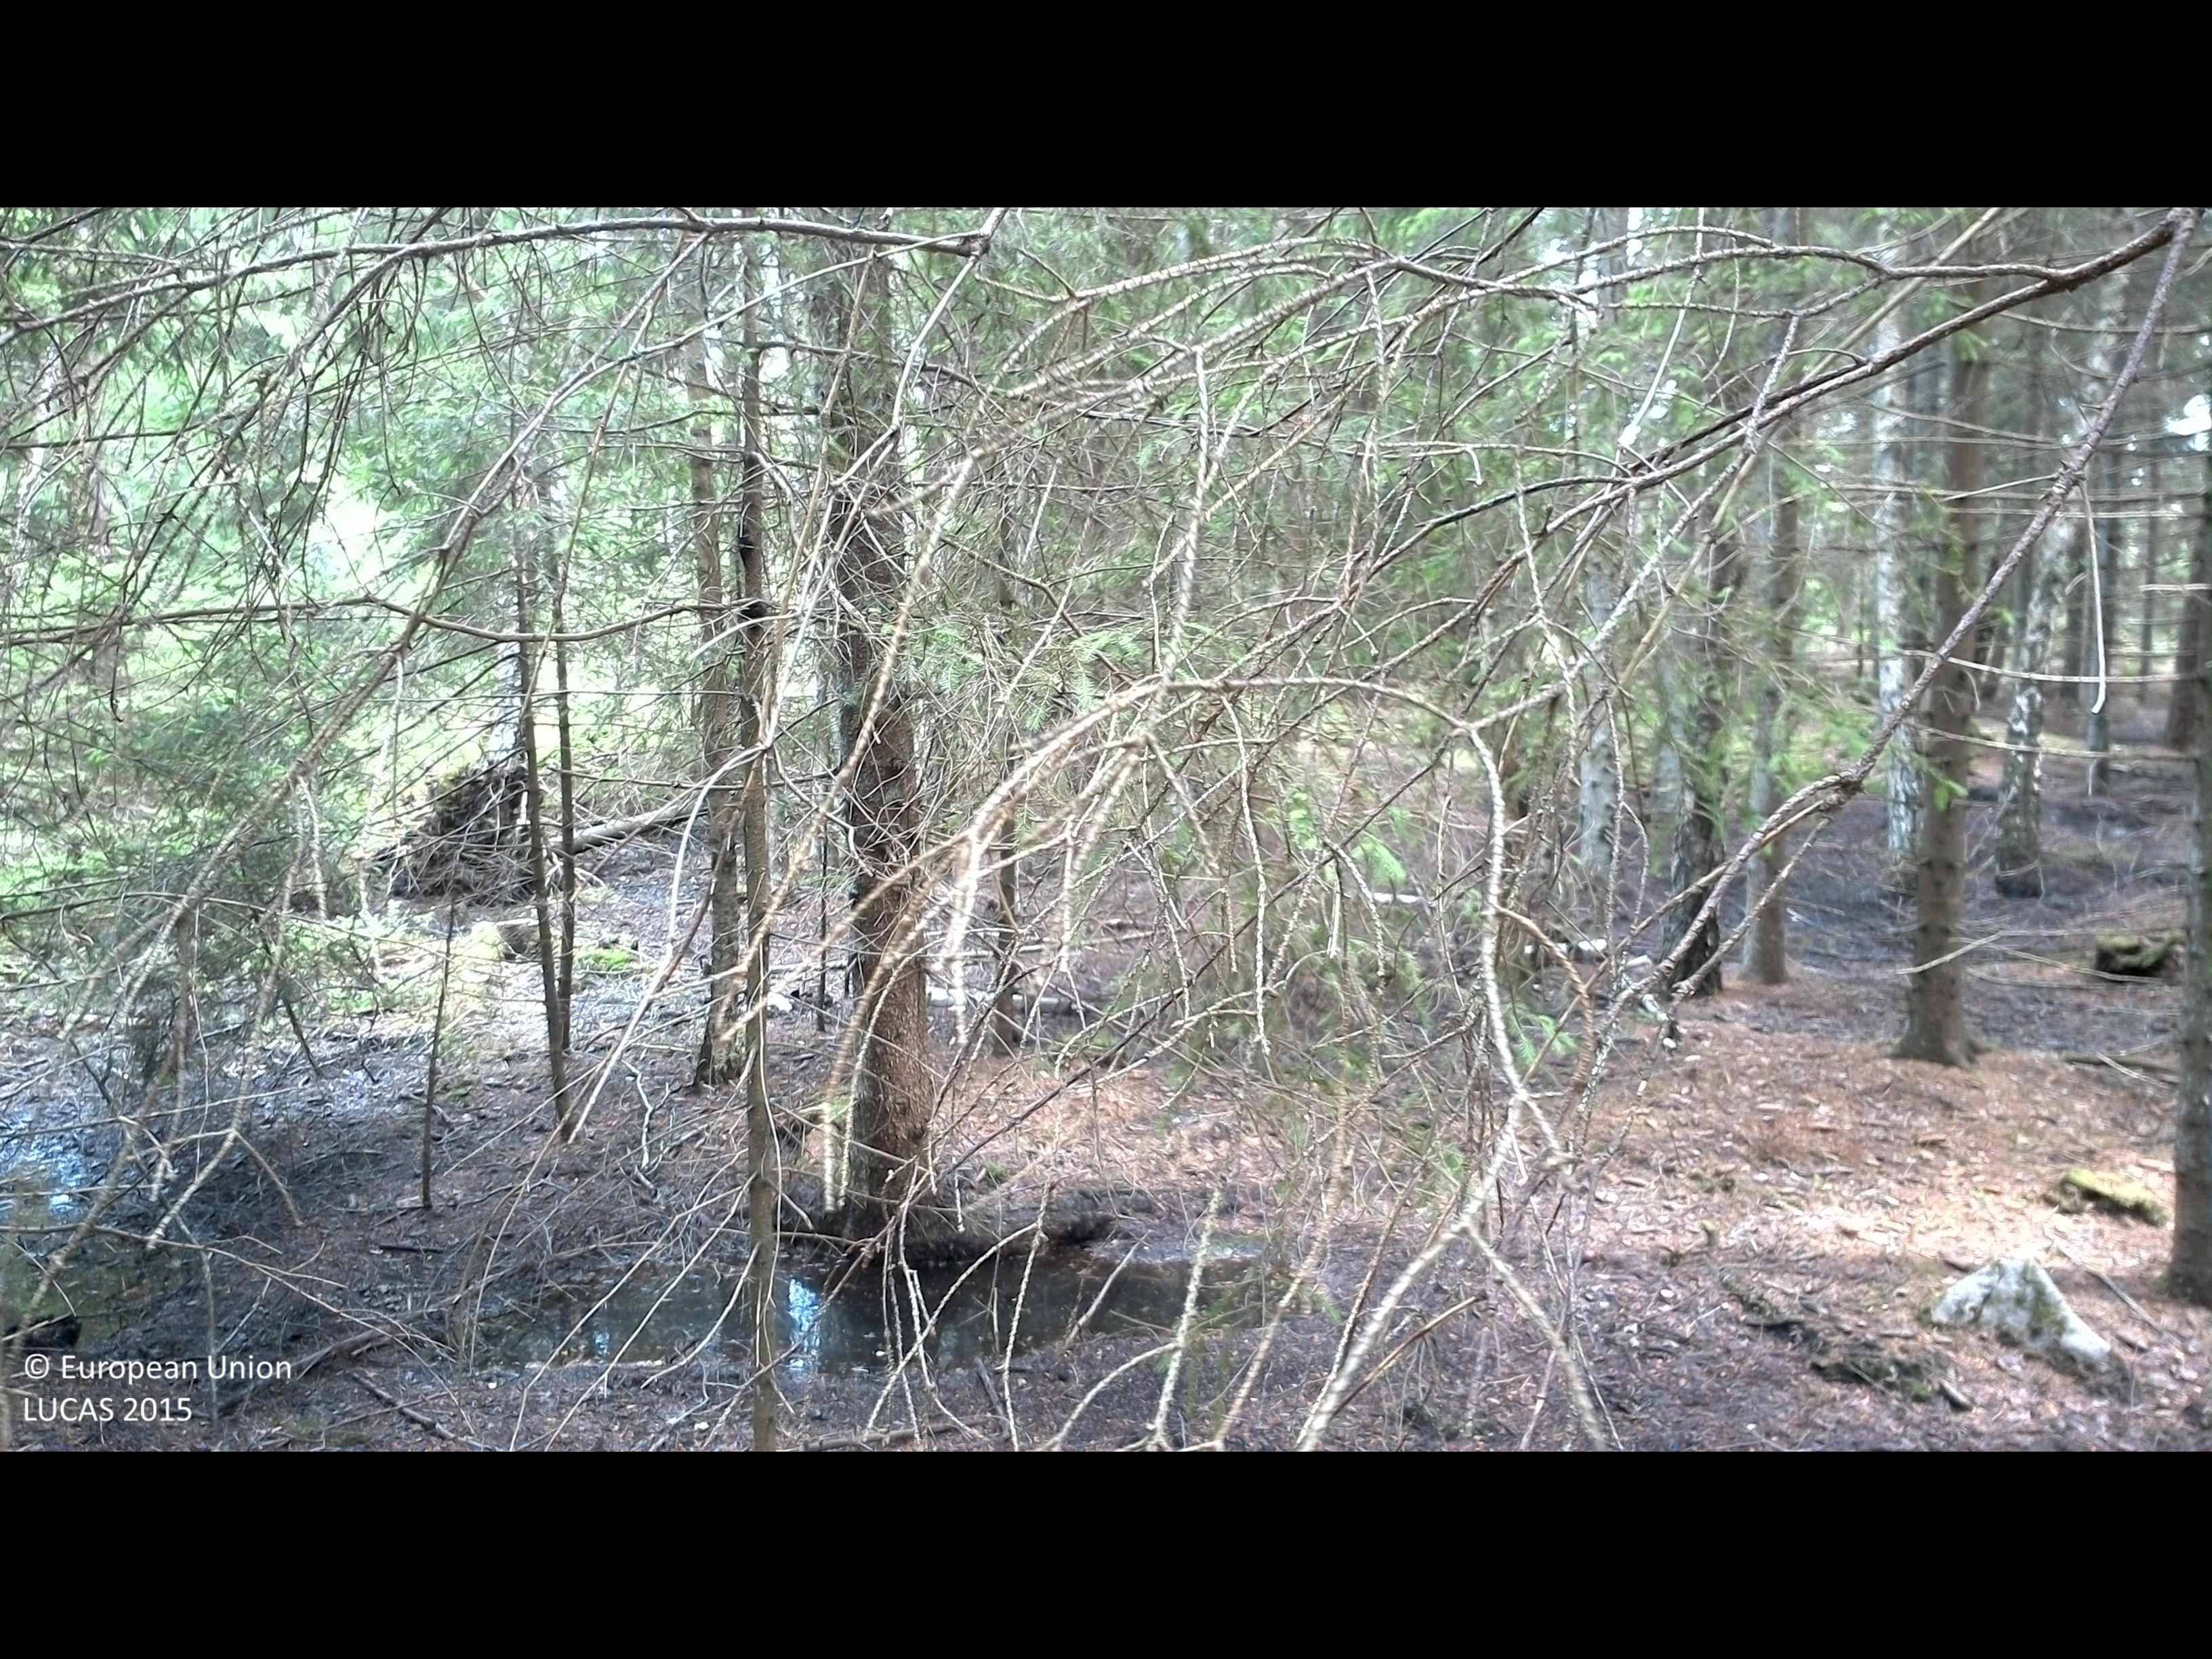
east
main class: Woodland
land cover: Spruce dominated coniferous woodland
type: boreal forest
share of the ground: > 75 %
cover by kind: coniferous forest trees 75 %, lichens and mosses 15 %, broadleaved forest trees 10 %
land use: Forestry
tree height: > 5 m
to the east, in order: Spruce dominated coniferous woodland; Spruce dominated mixed woodland; Tracks; Pine dominated mixed woodland; Spruce dominated coniferous woodland; Ditches and canals; Spruce dominated coniferous woodland; Spruce dominated mixed woodland; Spruce dominated coniferous woodland
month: June
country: SE
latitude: 56.4314
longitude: 15.8865
